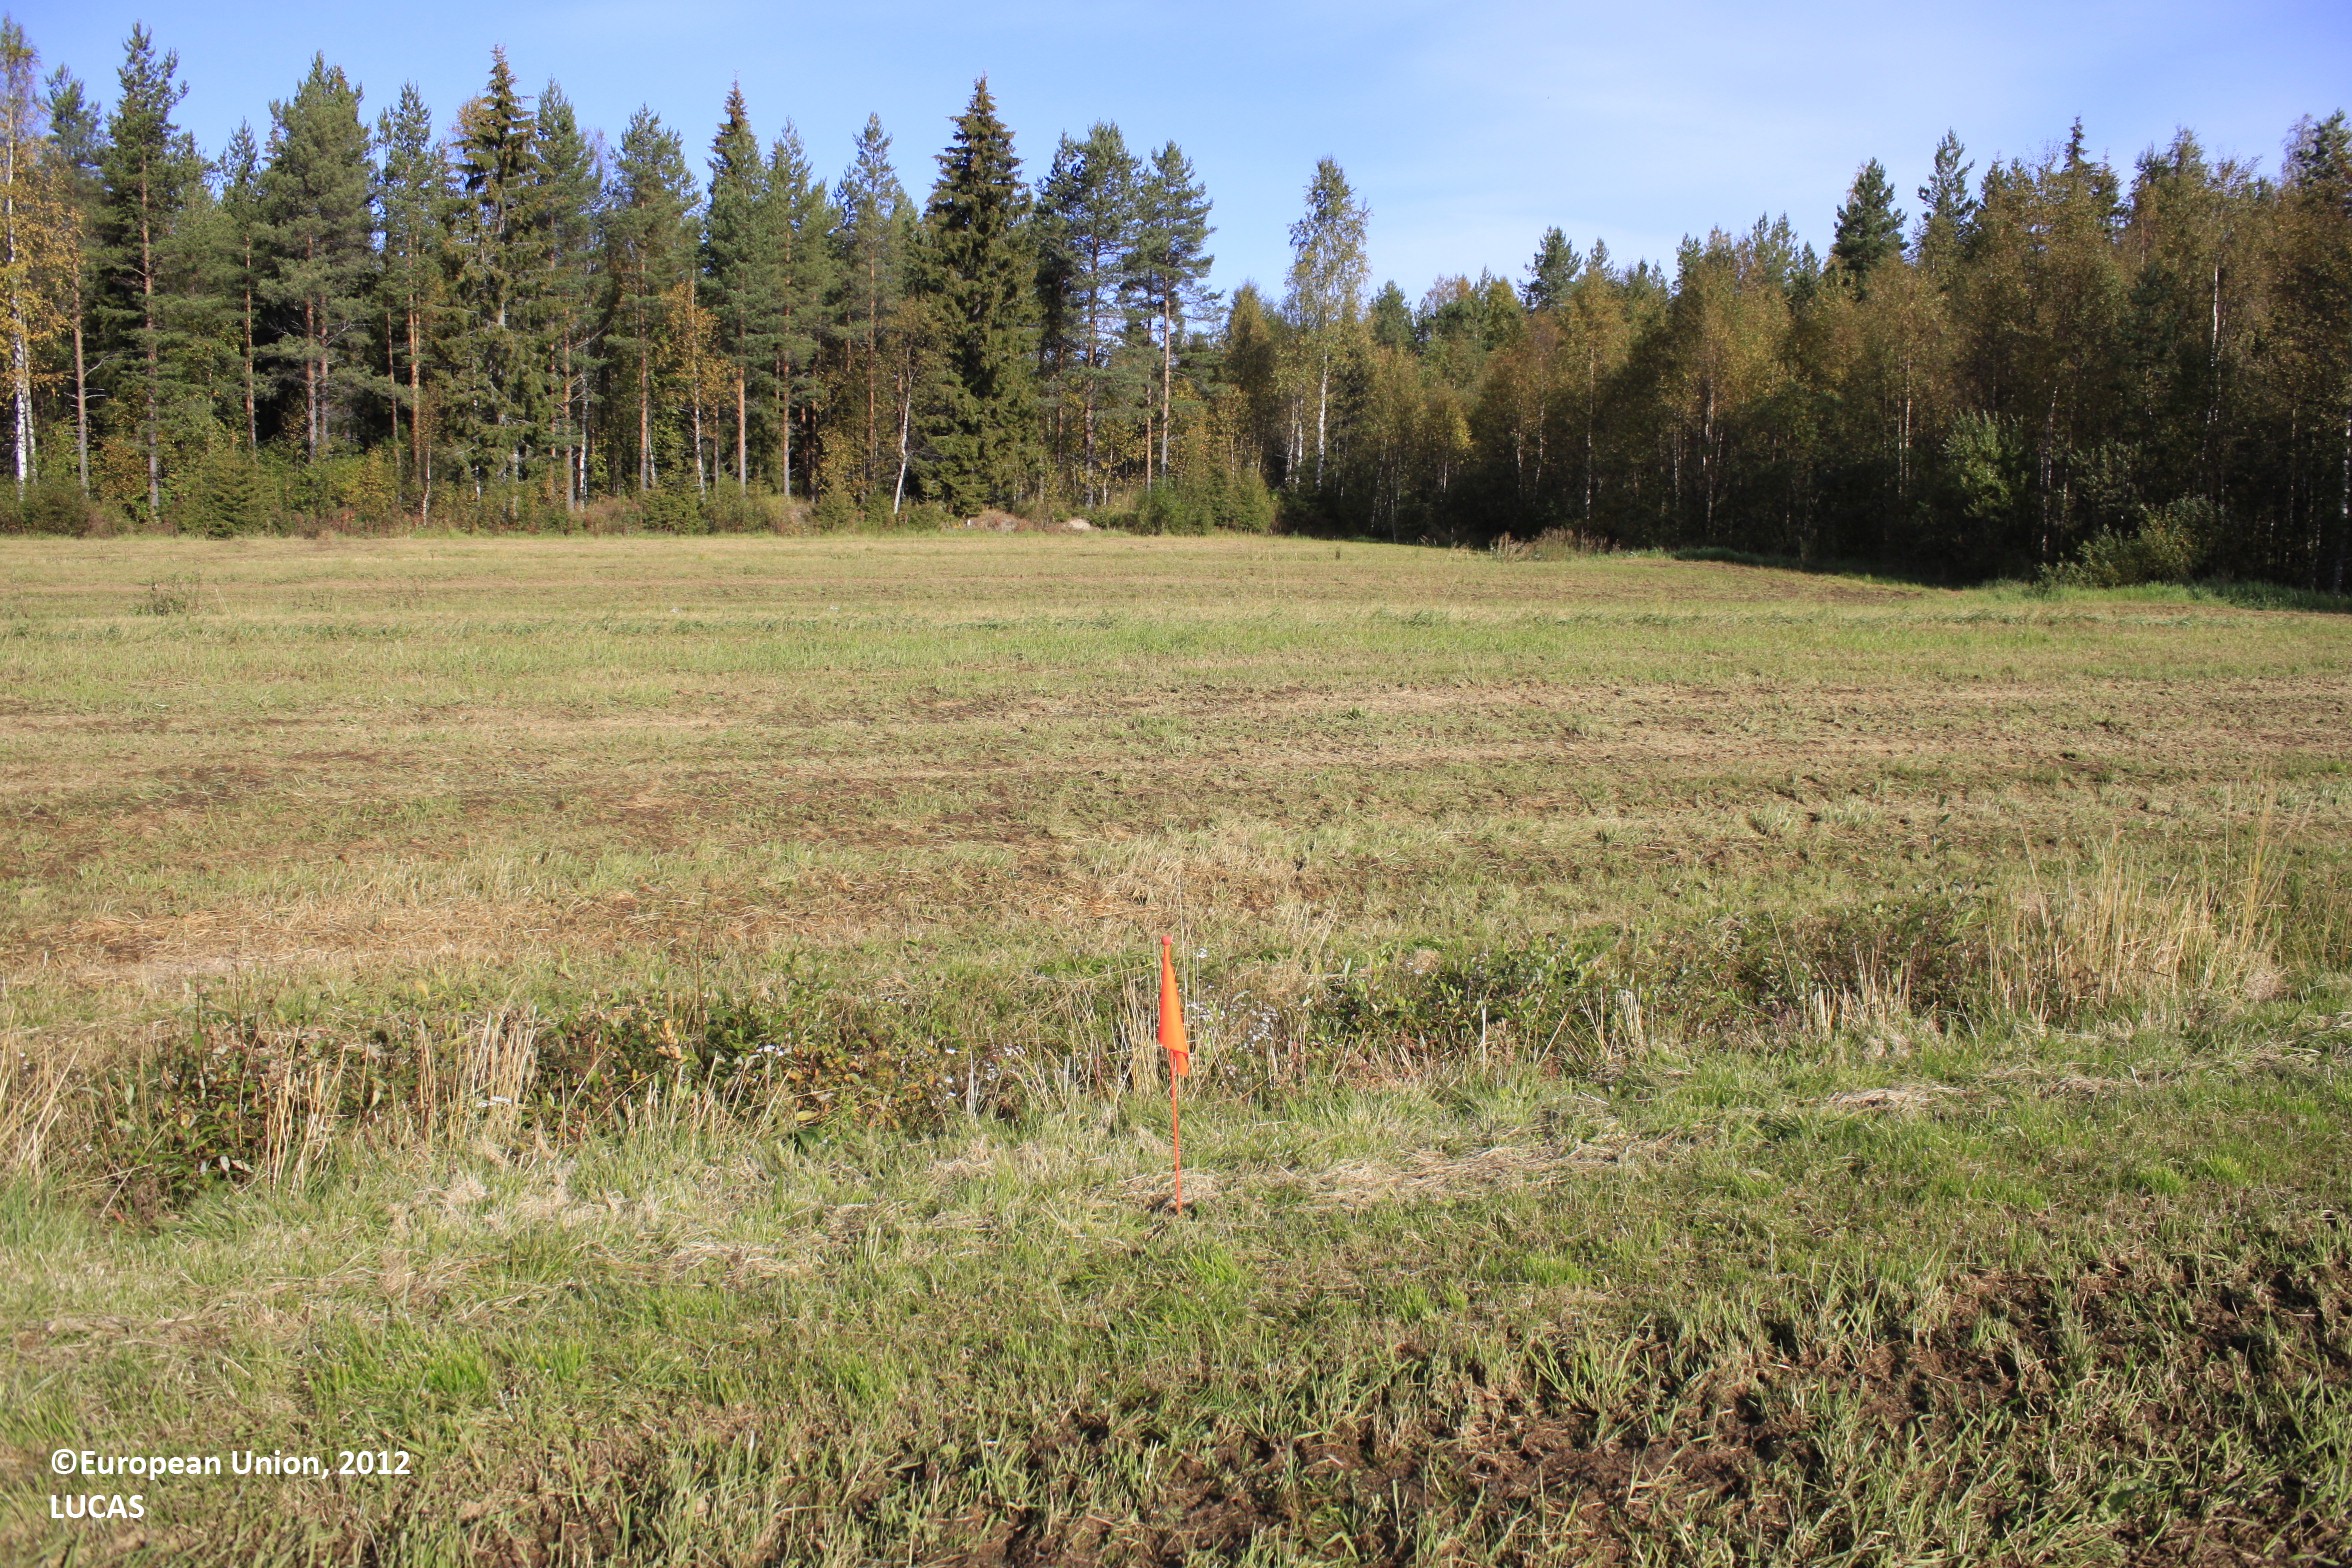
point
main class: Grassland
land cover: Grassland without tree/shrub cover
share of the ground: > 75 %
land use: Agriculture (excluding fallow land and kitchen gardens)
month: September
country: FI
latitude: 65.5888
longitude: 27.1848
